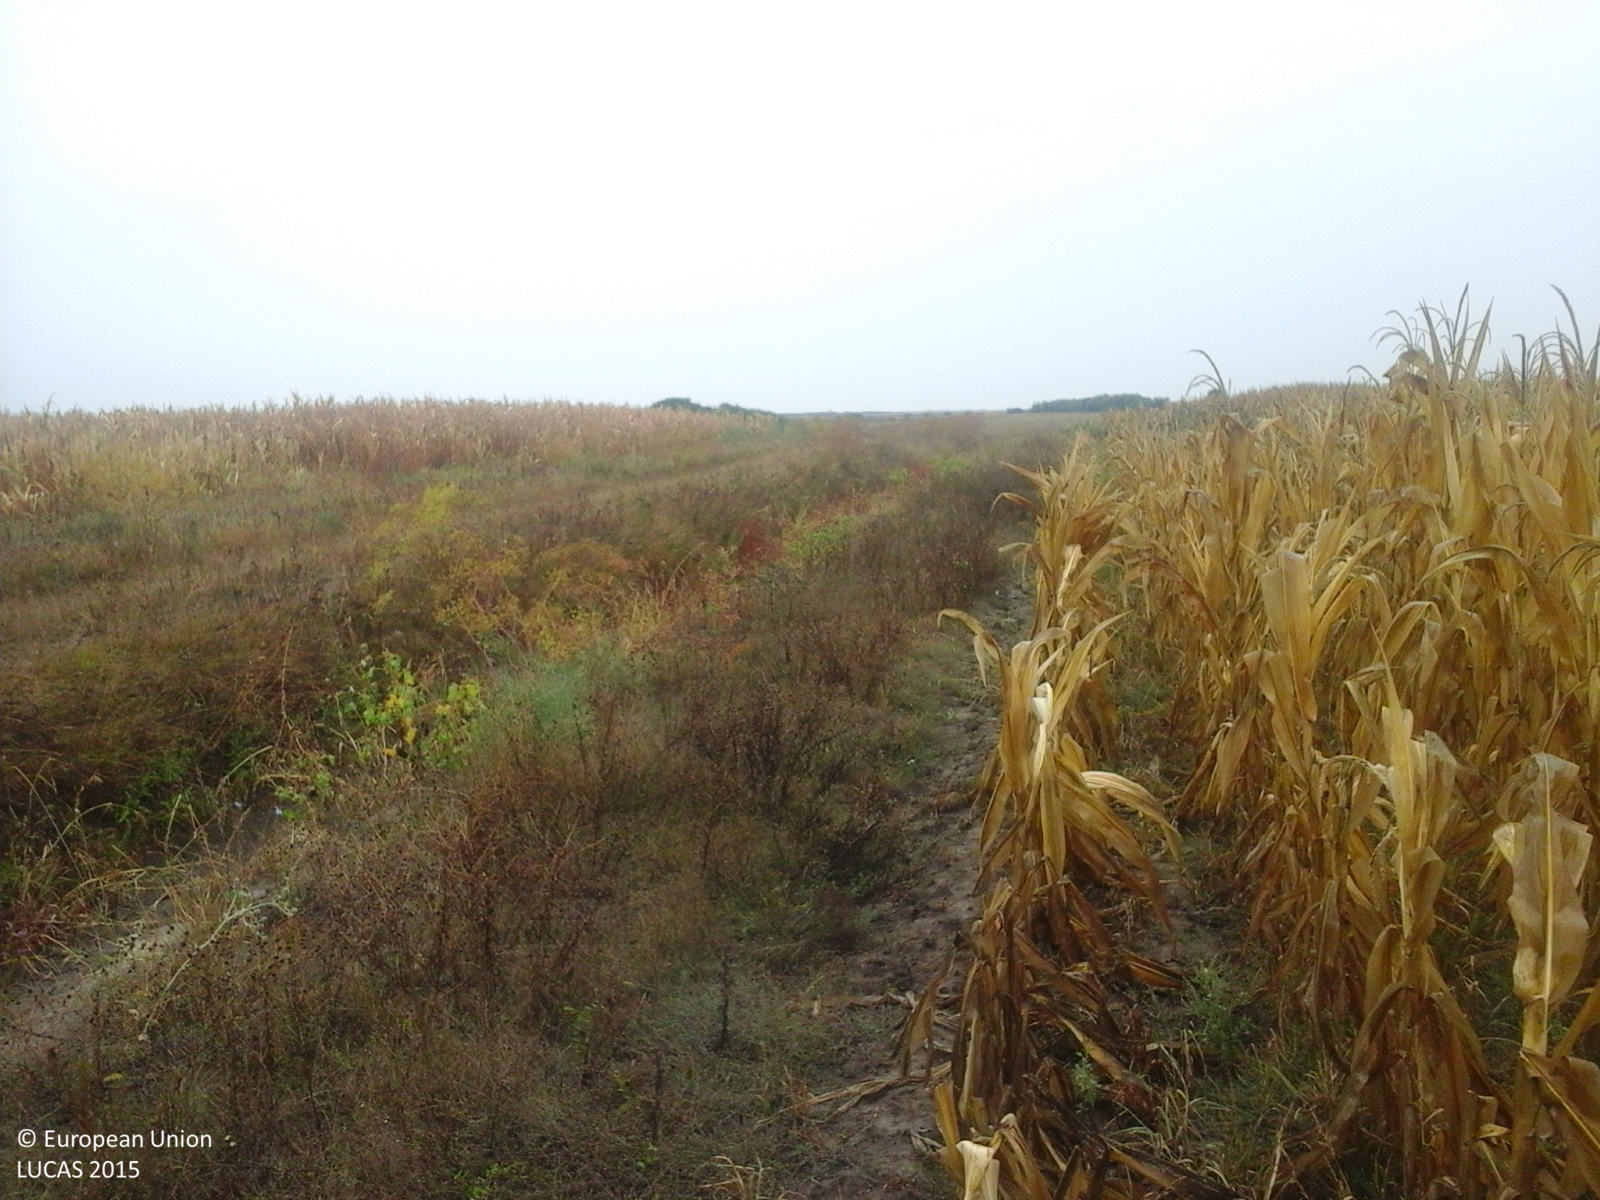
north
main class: Cropland
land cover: Maize
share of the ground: > 75 %
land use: Agriculture (excluding fallow land and kitchen gardens)
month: September
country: RO
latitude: 47.5884
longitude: 22.5985
